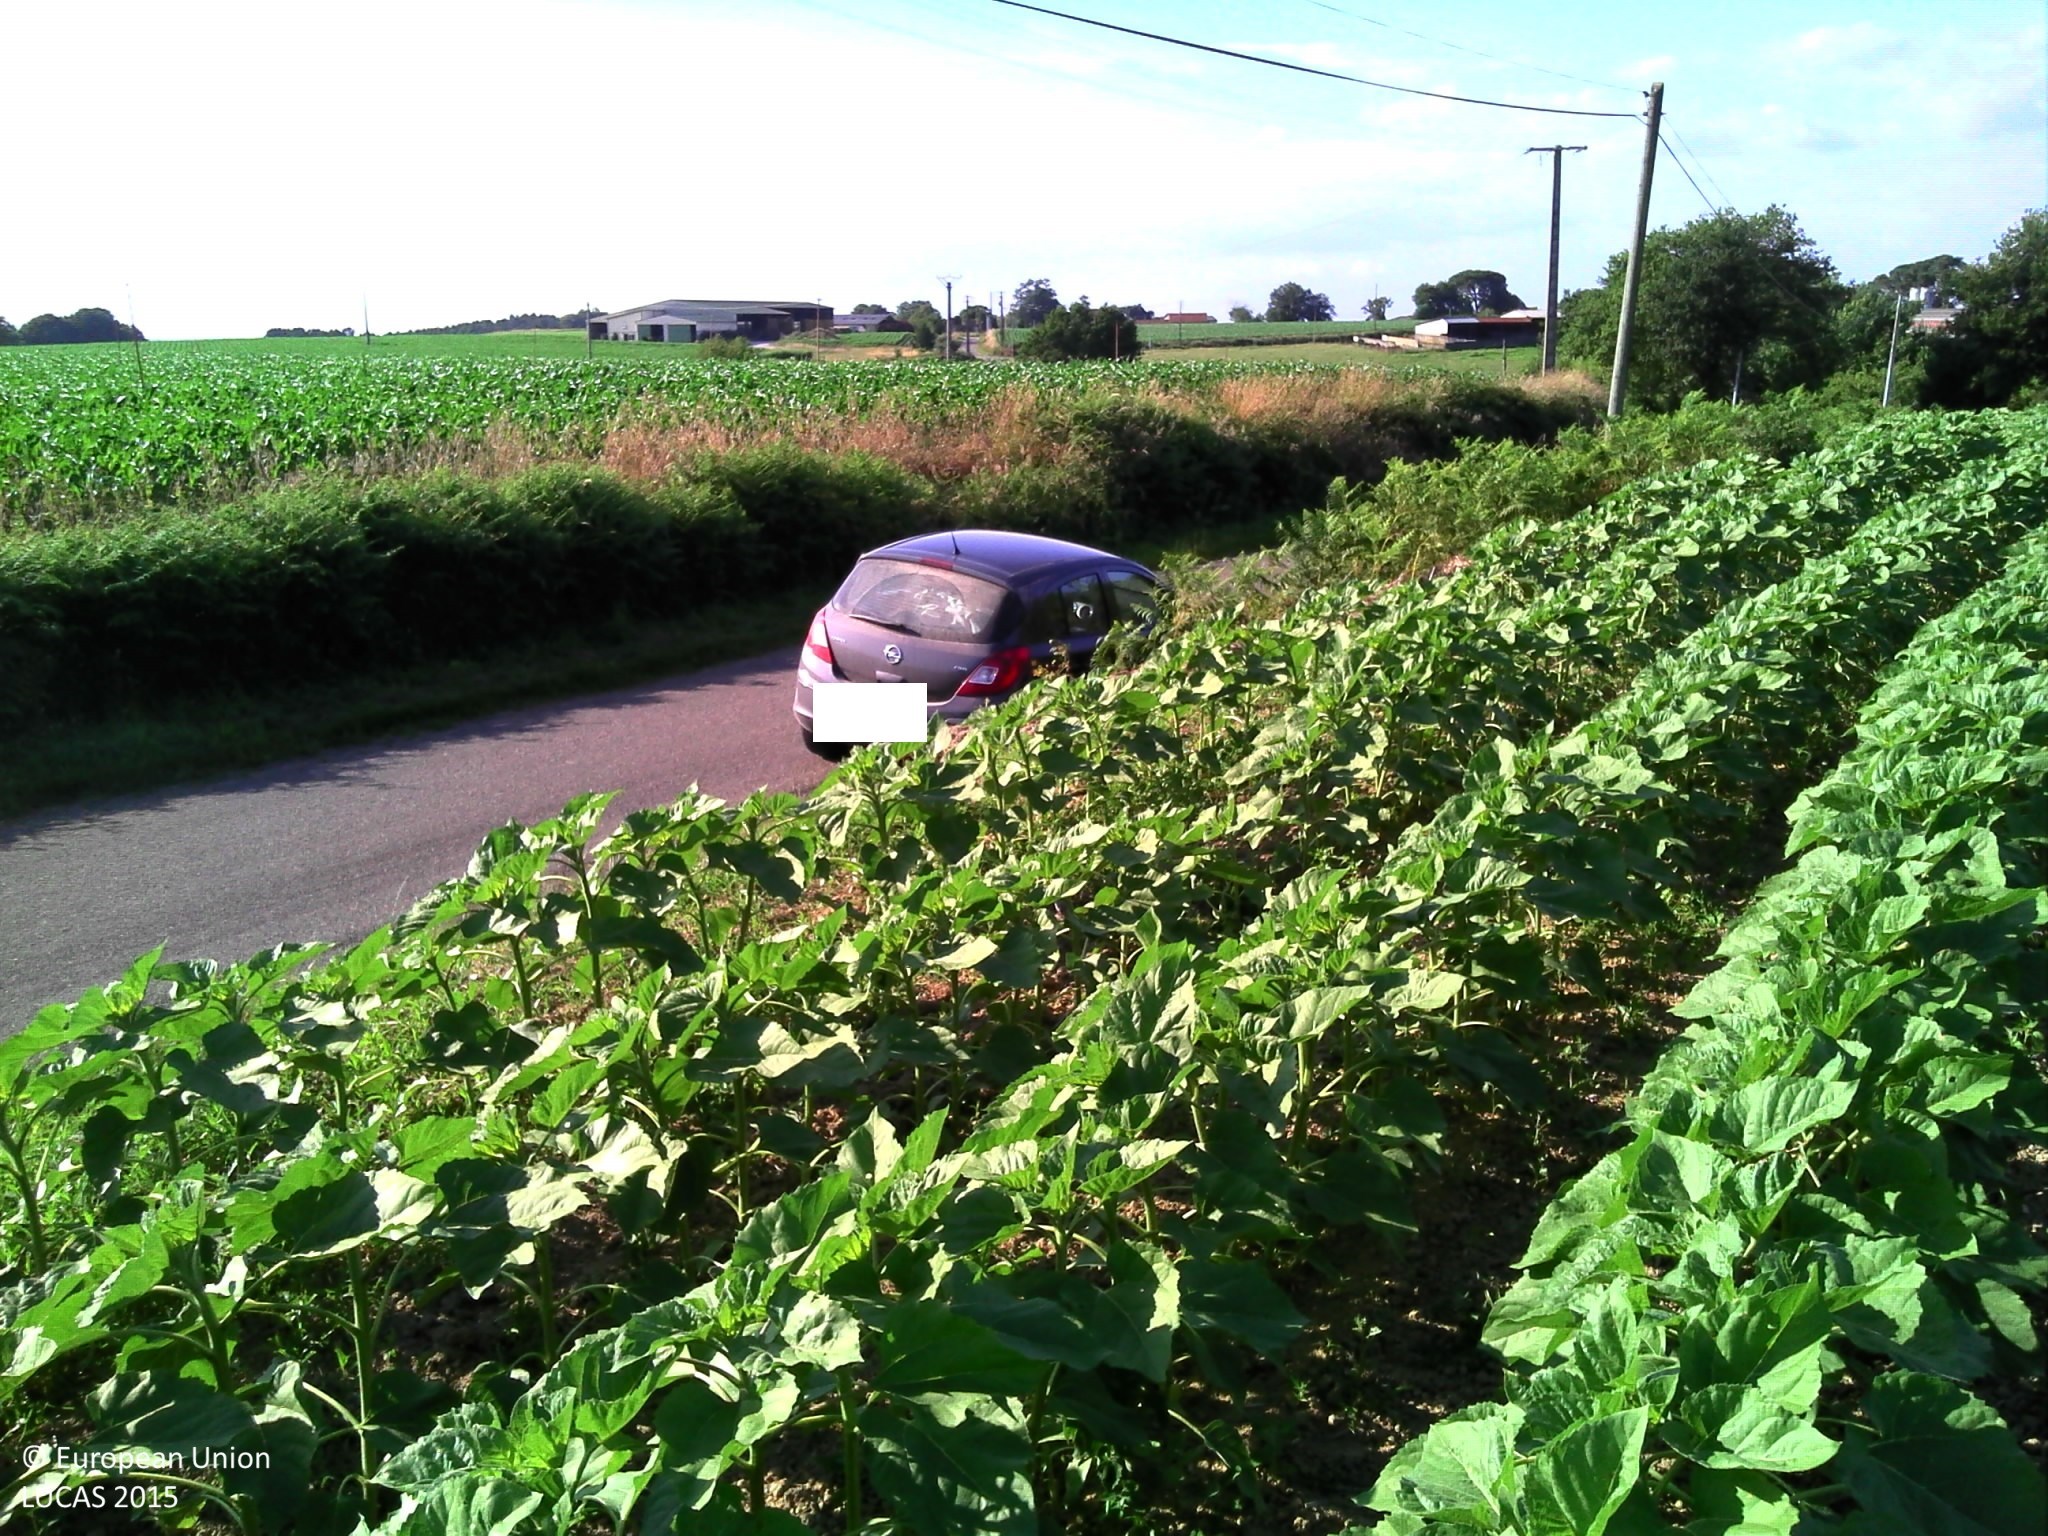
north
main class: Cropland
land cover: Sunflower
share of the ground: > 75 %
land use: Agriculture (excluding fallow land and kitchen gardens)
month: June
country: FR
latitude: 43.5674
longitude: -0.4466
